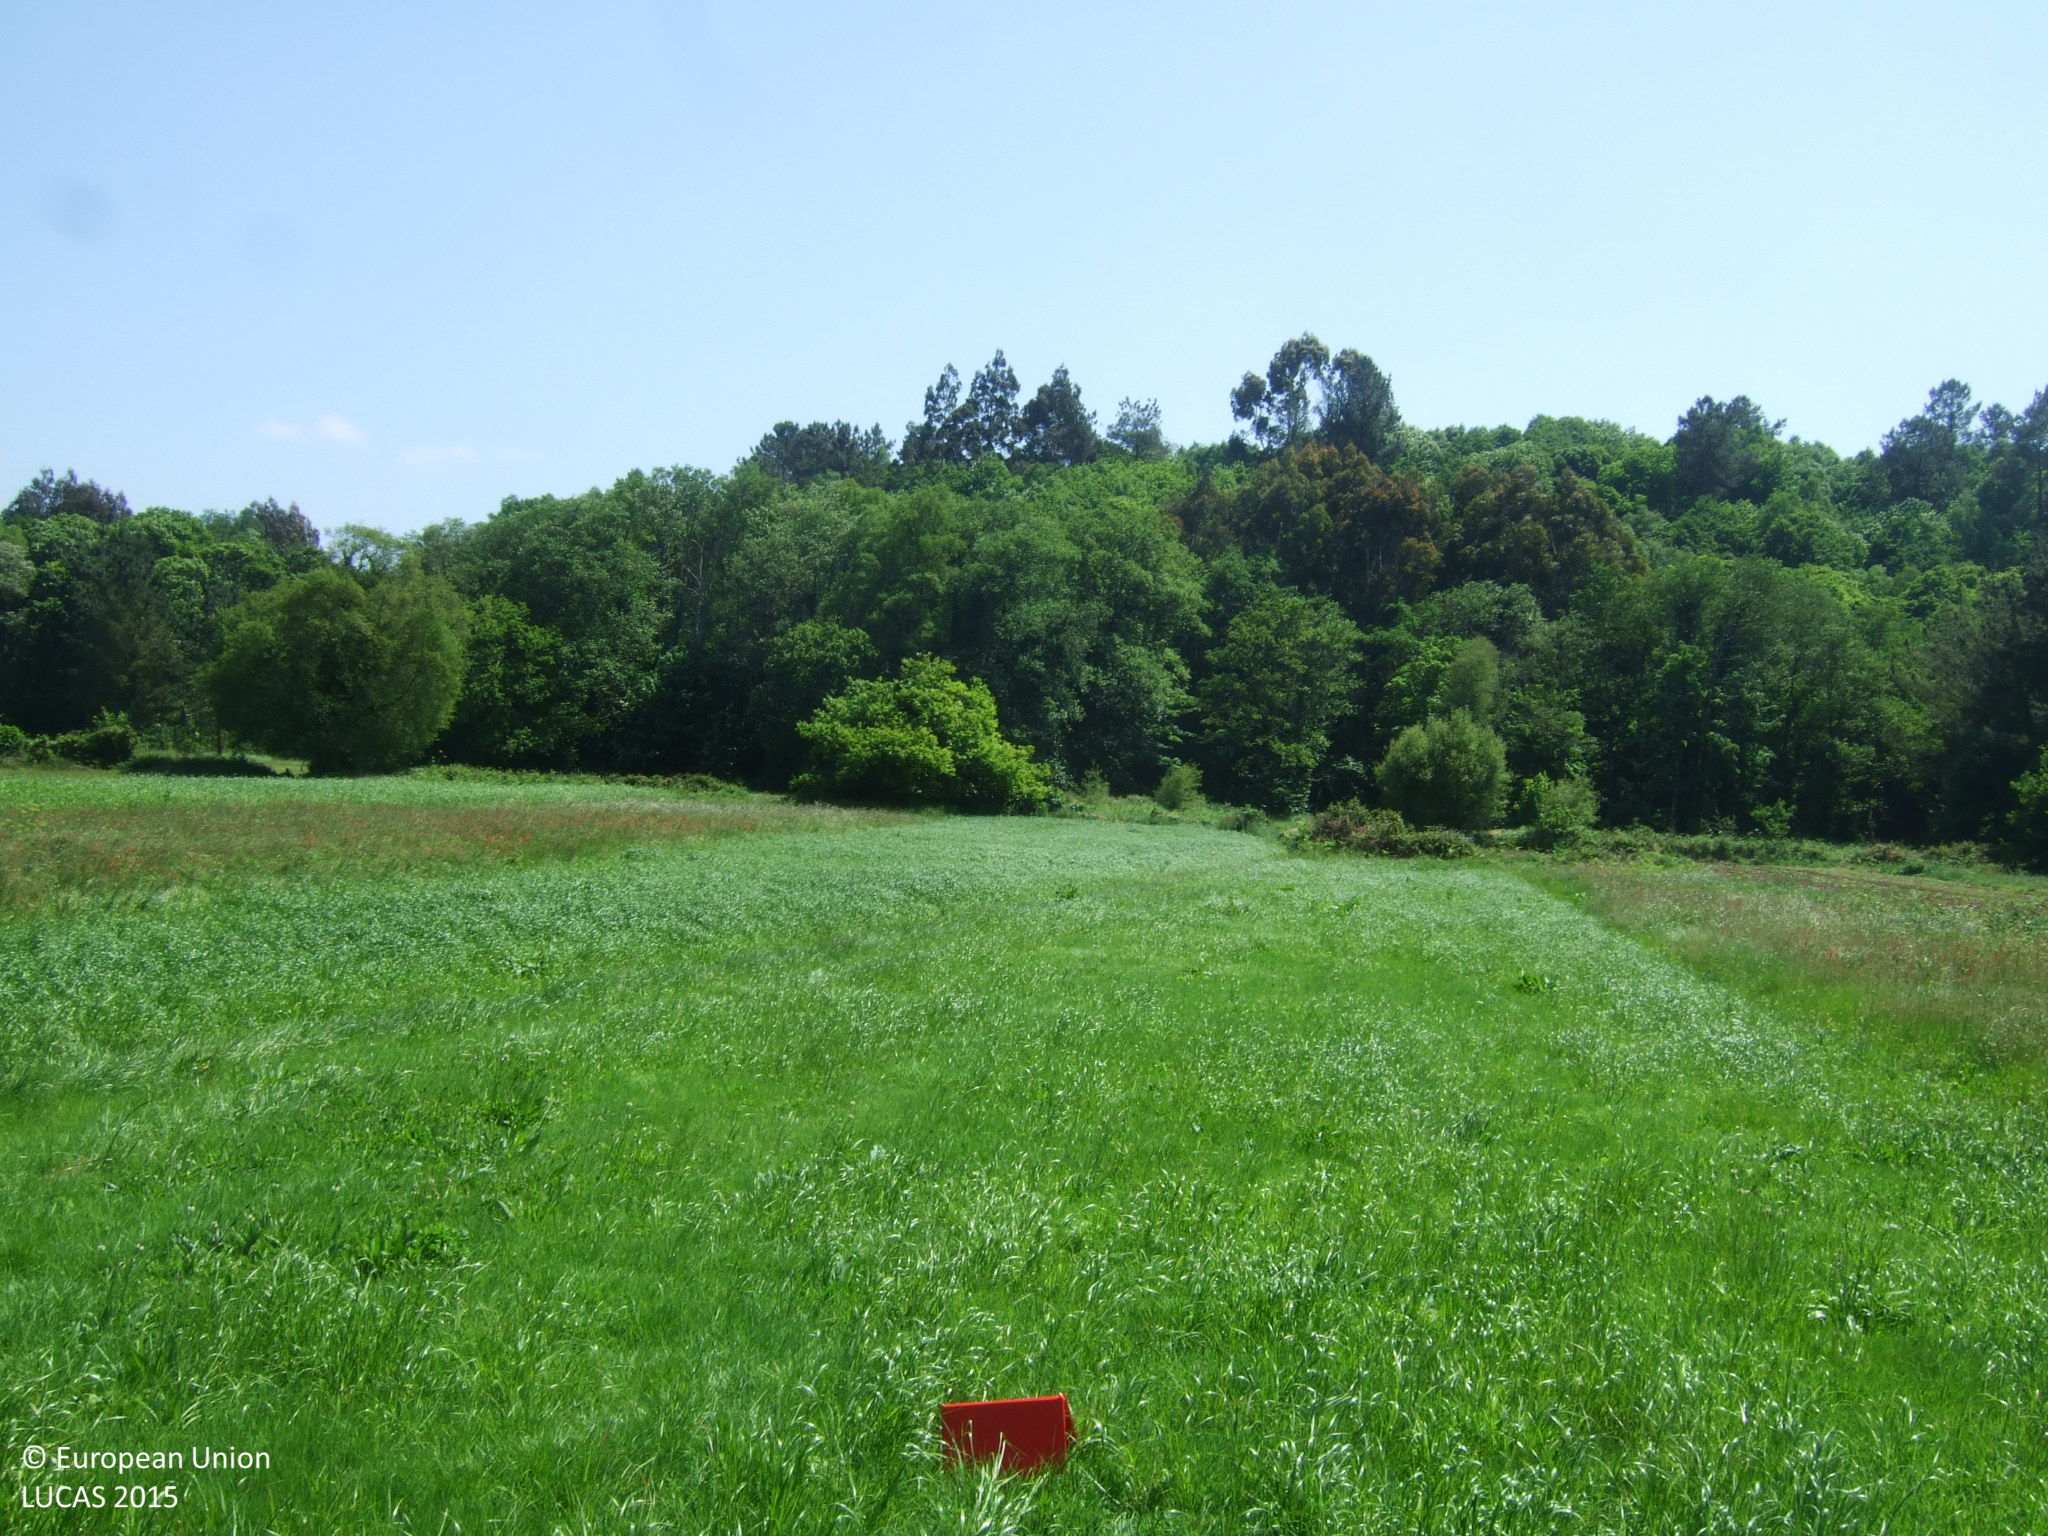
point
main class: Grassland
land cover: Grassland without tree/shrub cover
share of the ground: > 75 %
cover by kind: herbaceous plants 100 %
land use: Agriculture (excluding fallow land and kitchen gardens)
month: June
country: ES
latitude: 43.3098
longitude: -7.5000
